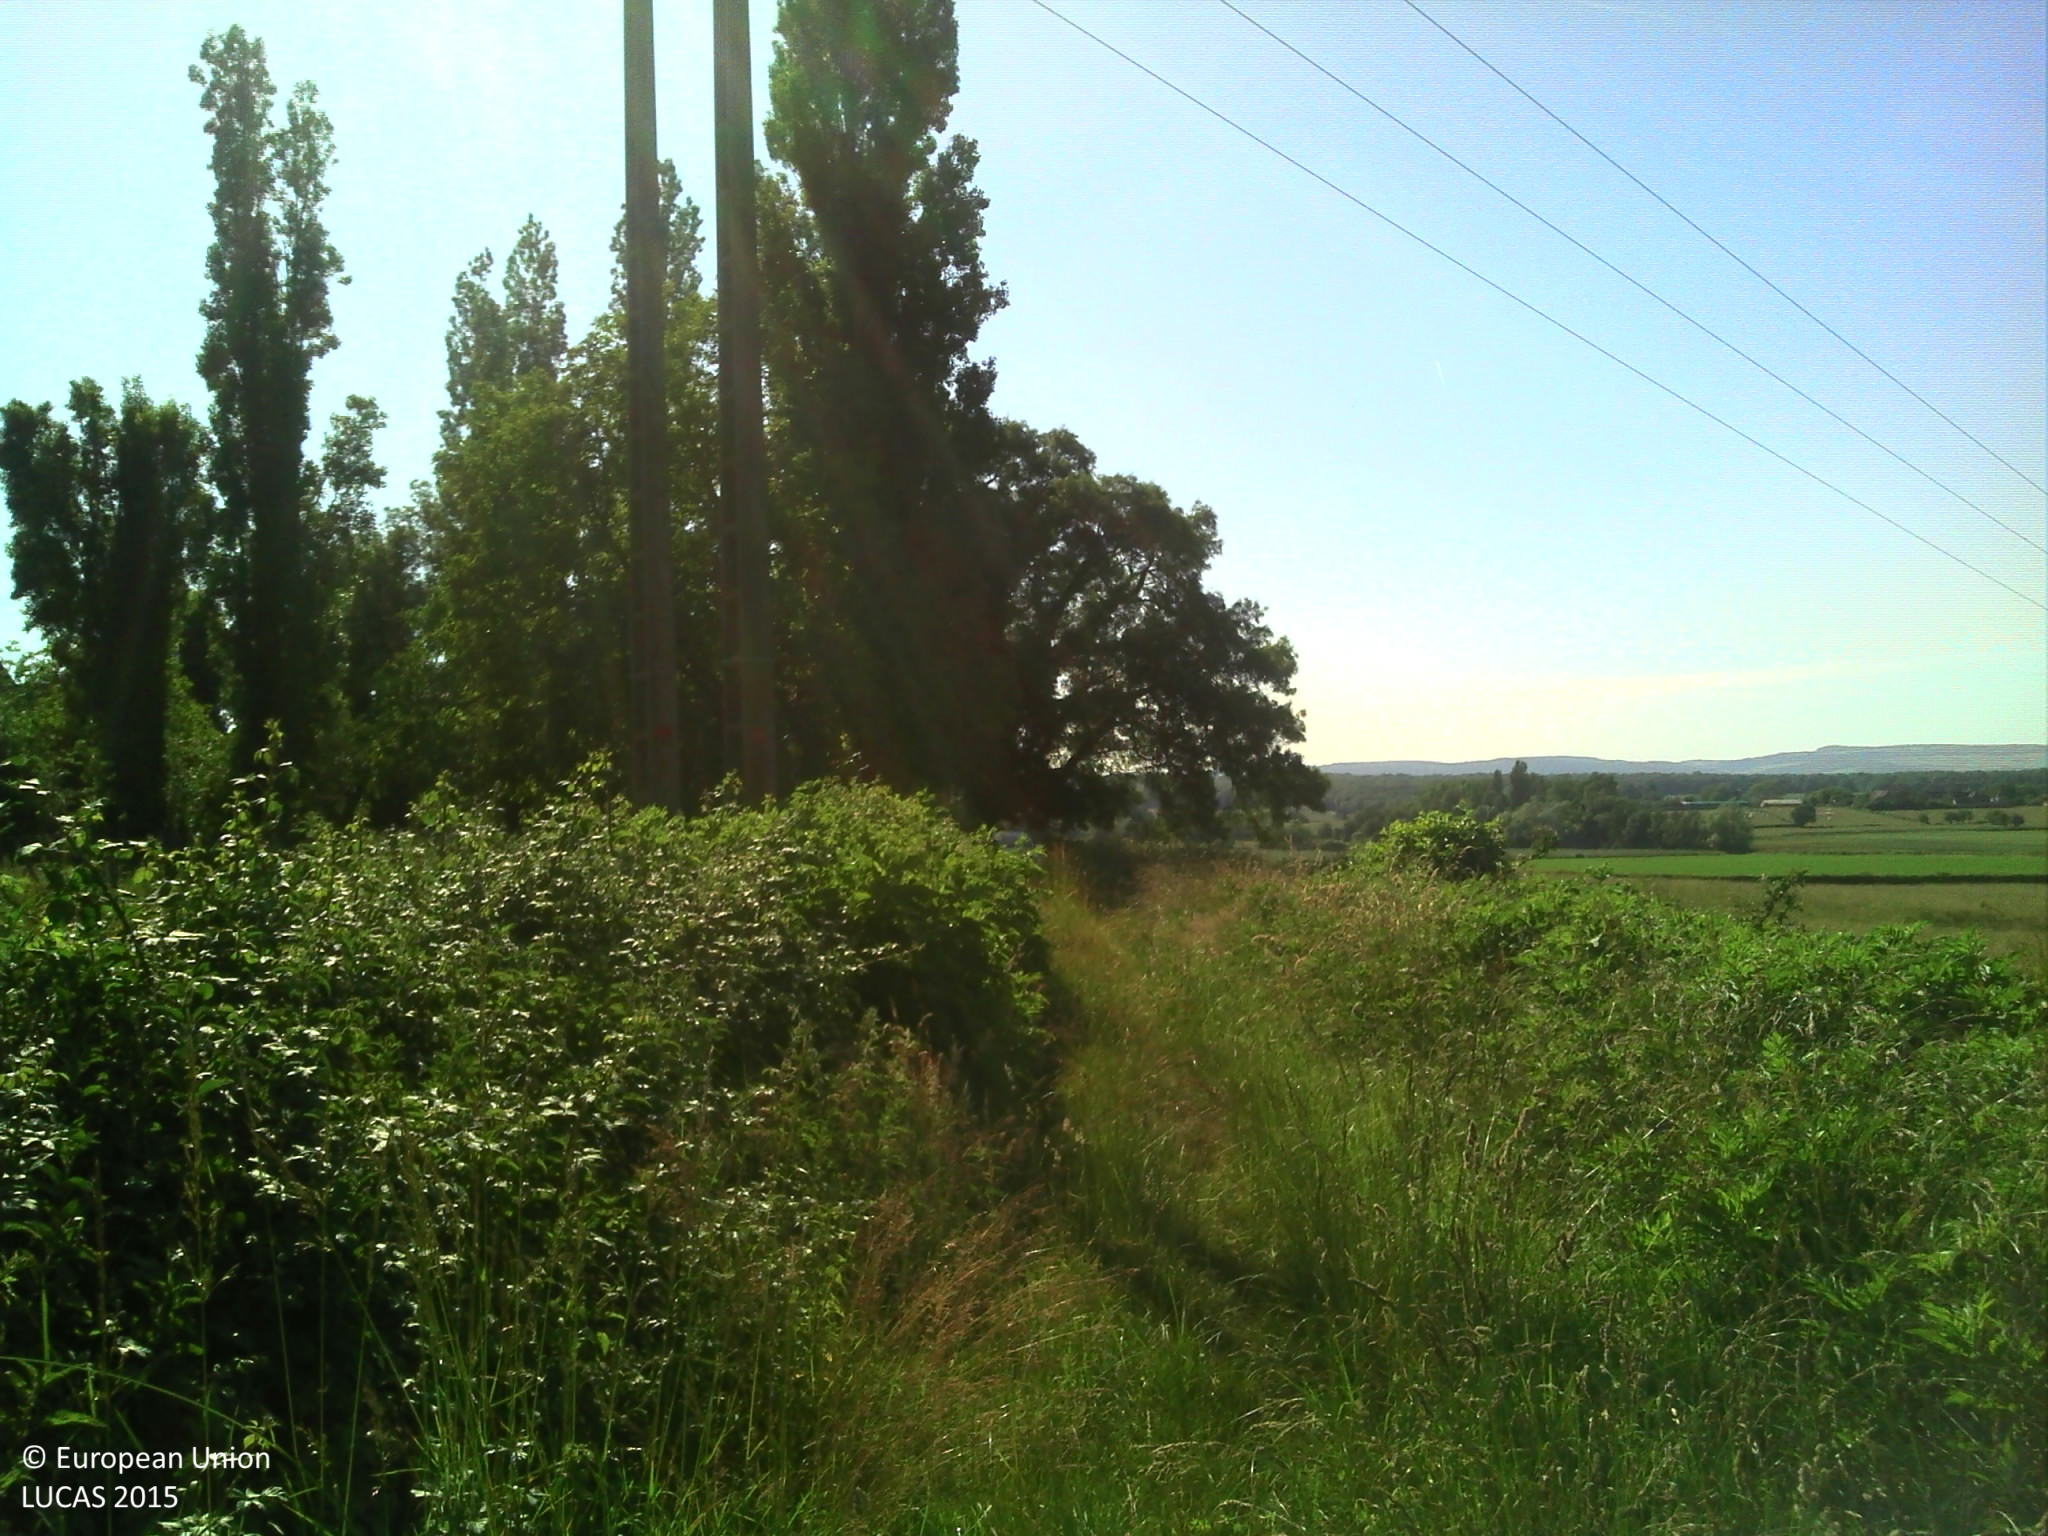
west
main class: Grassland
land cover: Grassland without tree/shrub cover
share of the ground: > 75 %
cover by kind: herbaceous plants 85 %, unconsolidated bare surface 15 %
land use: Agriculture (excluding fallow land and kitchen gardens)
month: June
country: FR
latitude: 46.5854
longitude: 4.7944
